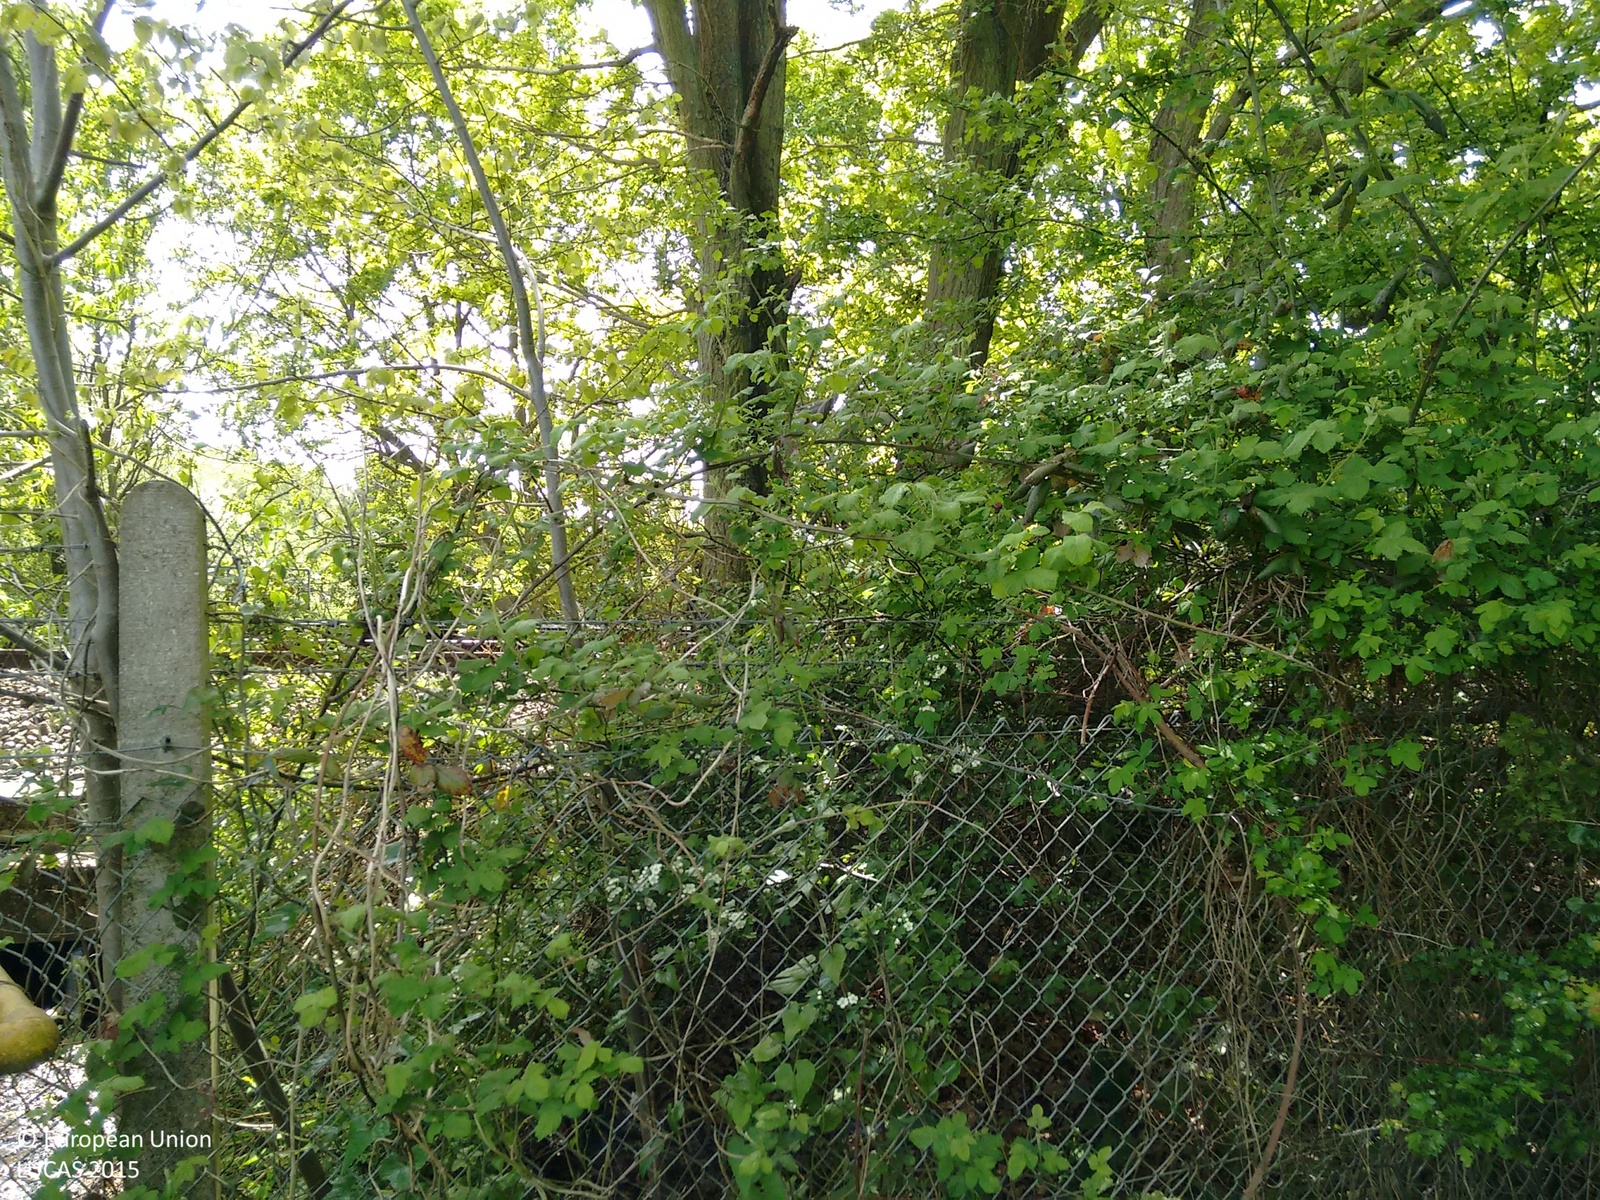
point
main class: Woodland
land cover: Broadleaved woodland
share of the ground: 25 - 50 %
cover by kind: broadleaved forest trees 45 %, herbaceous plants 45 %, shrubs 10 %
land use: Railway transport
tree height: > 5 m
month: May
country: GB
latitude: 51.1776
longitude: 0.4592
